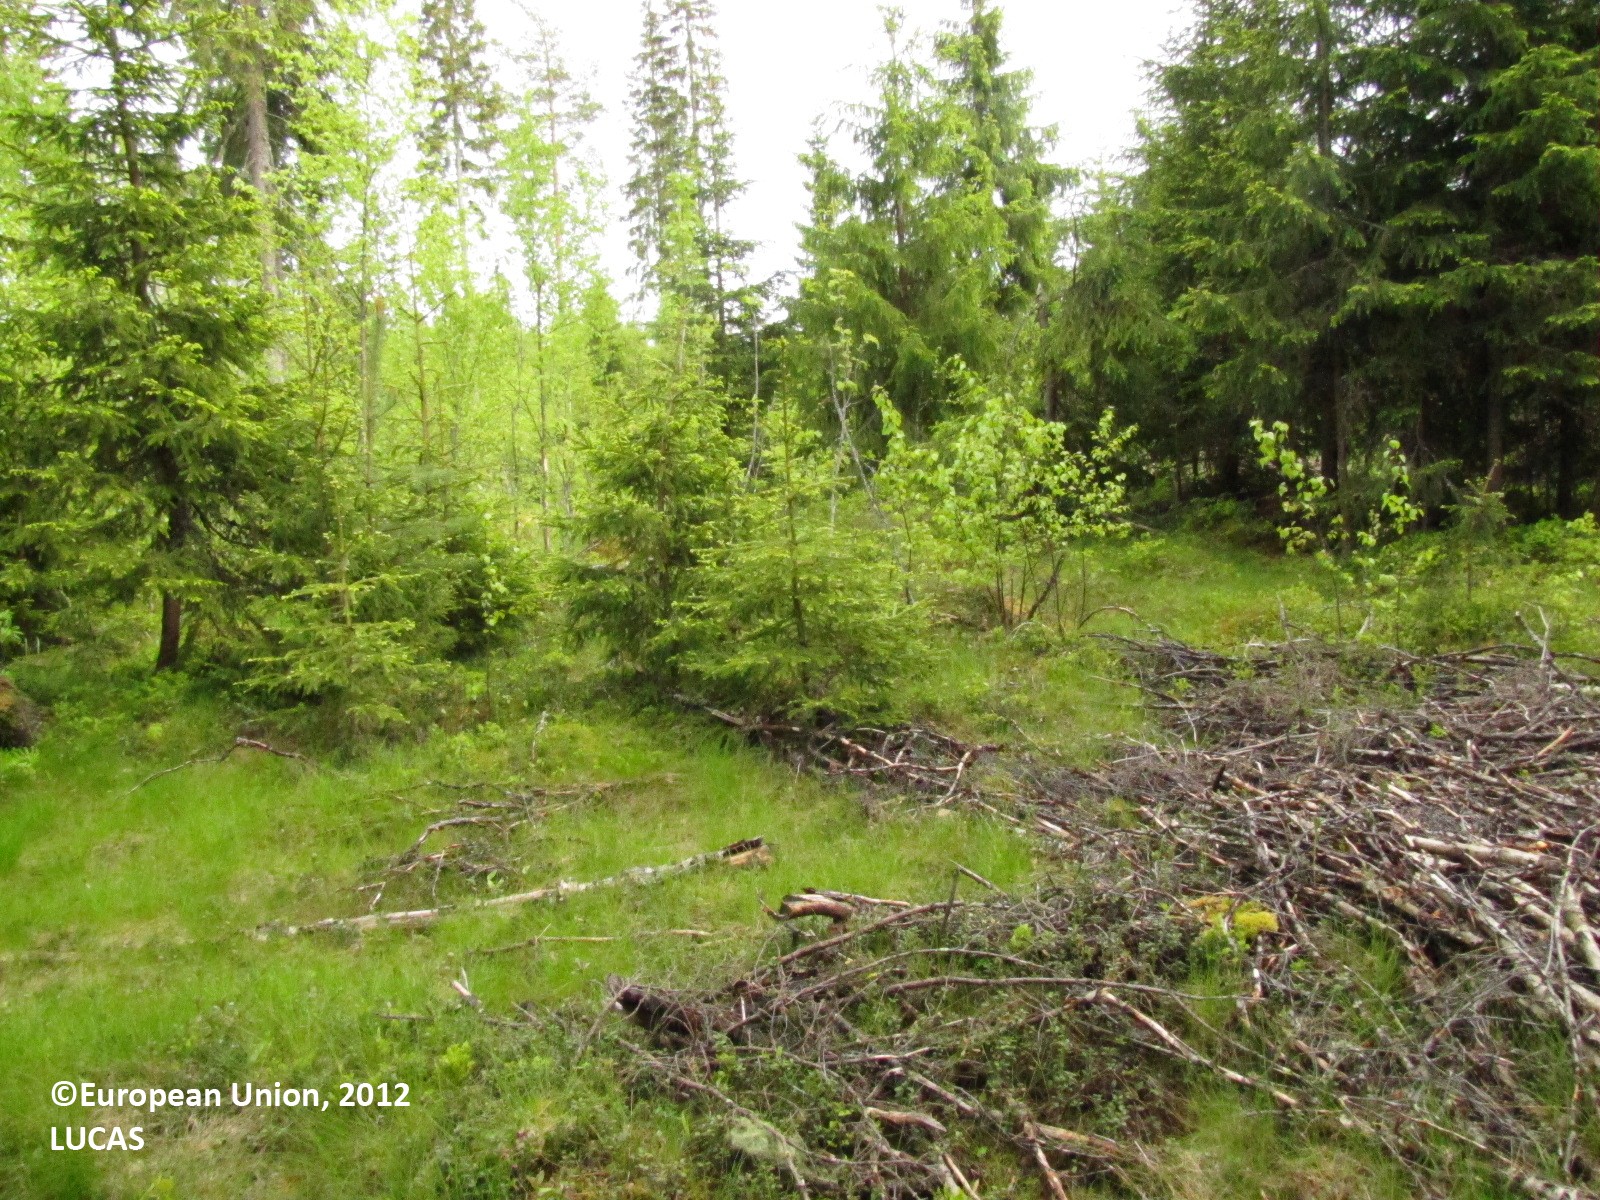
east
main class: Woodland
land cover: Spruce dominated mixed woodland
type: boreal forest
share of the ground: > 75 %
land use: Forestry
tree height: < 5 m
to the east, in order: Spruce dominated mixed woodland; Other mixed woodland; Ditches and canals; Spruce dominated mixed woodland; Ditches and canals; Spruce dominated mixed woodland; Ditches and canals; Spruce dominated mixed woodland
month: June
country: FI
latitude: 61.6398
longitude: 23.0352
